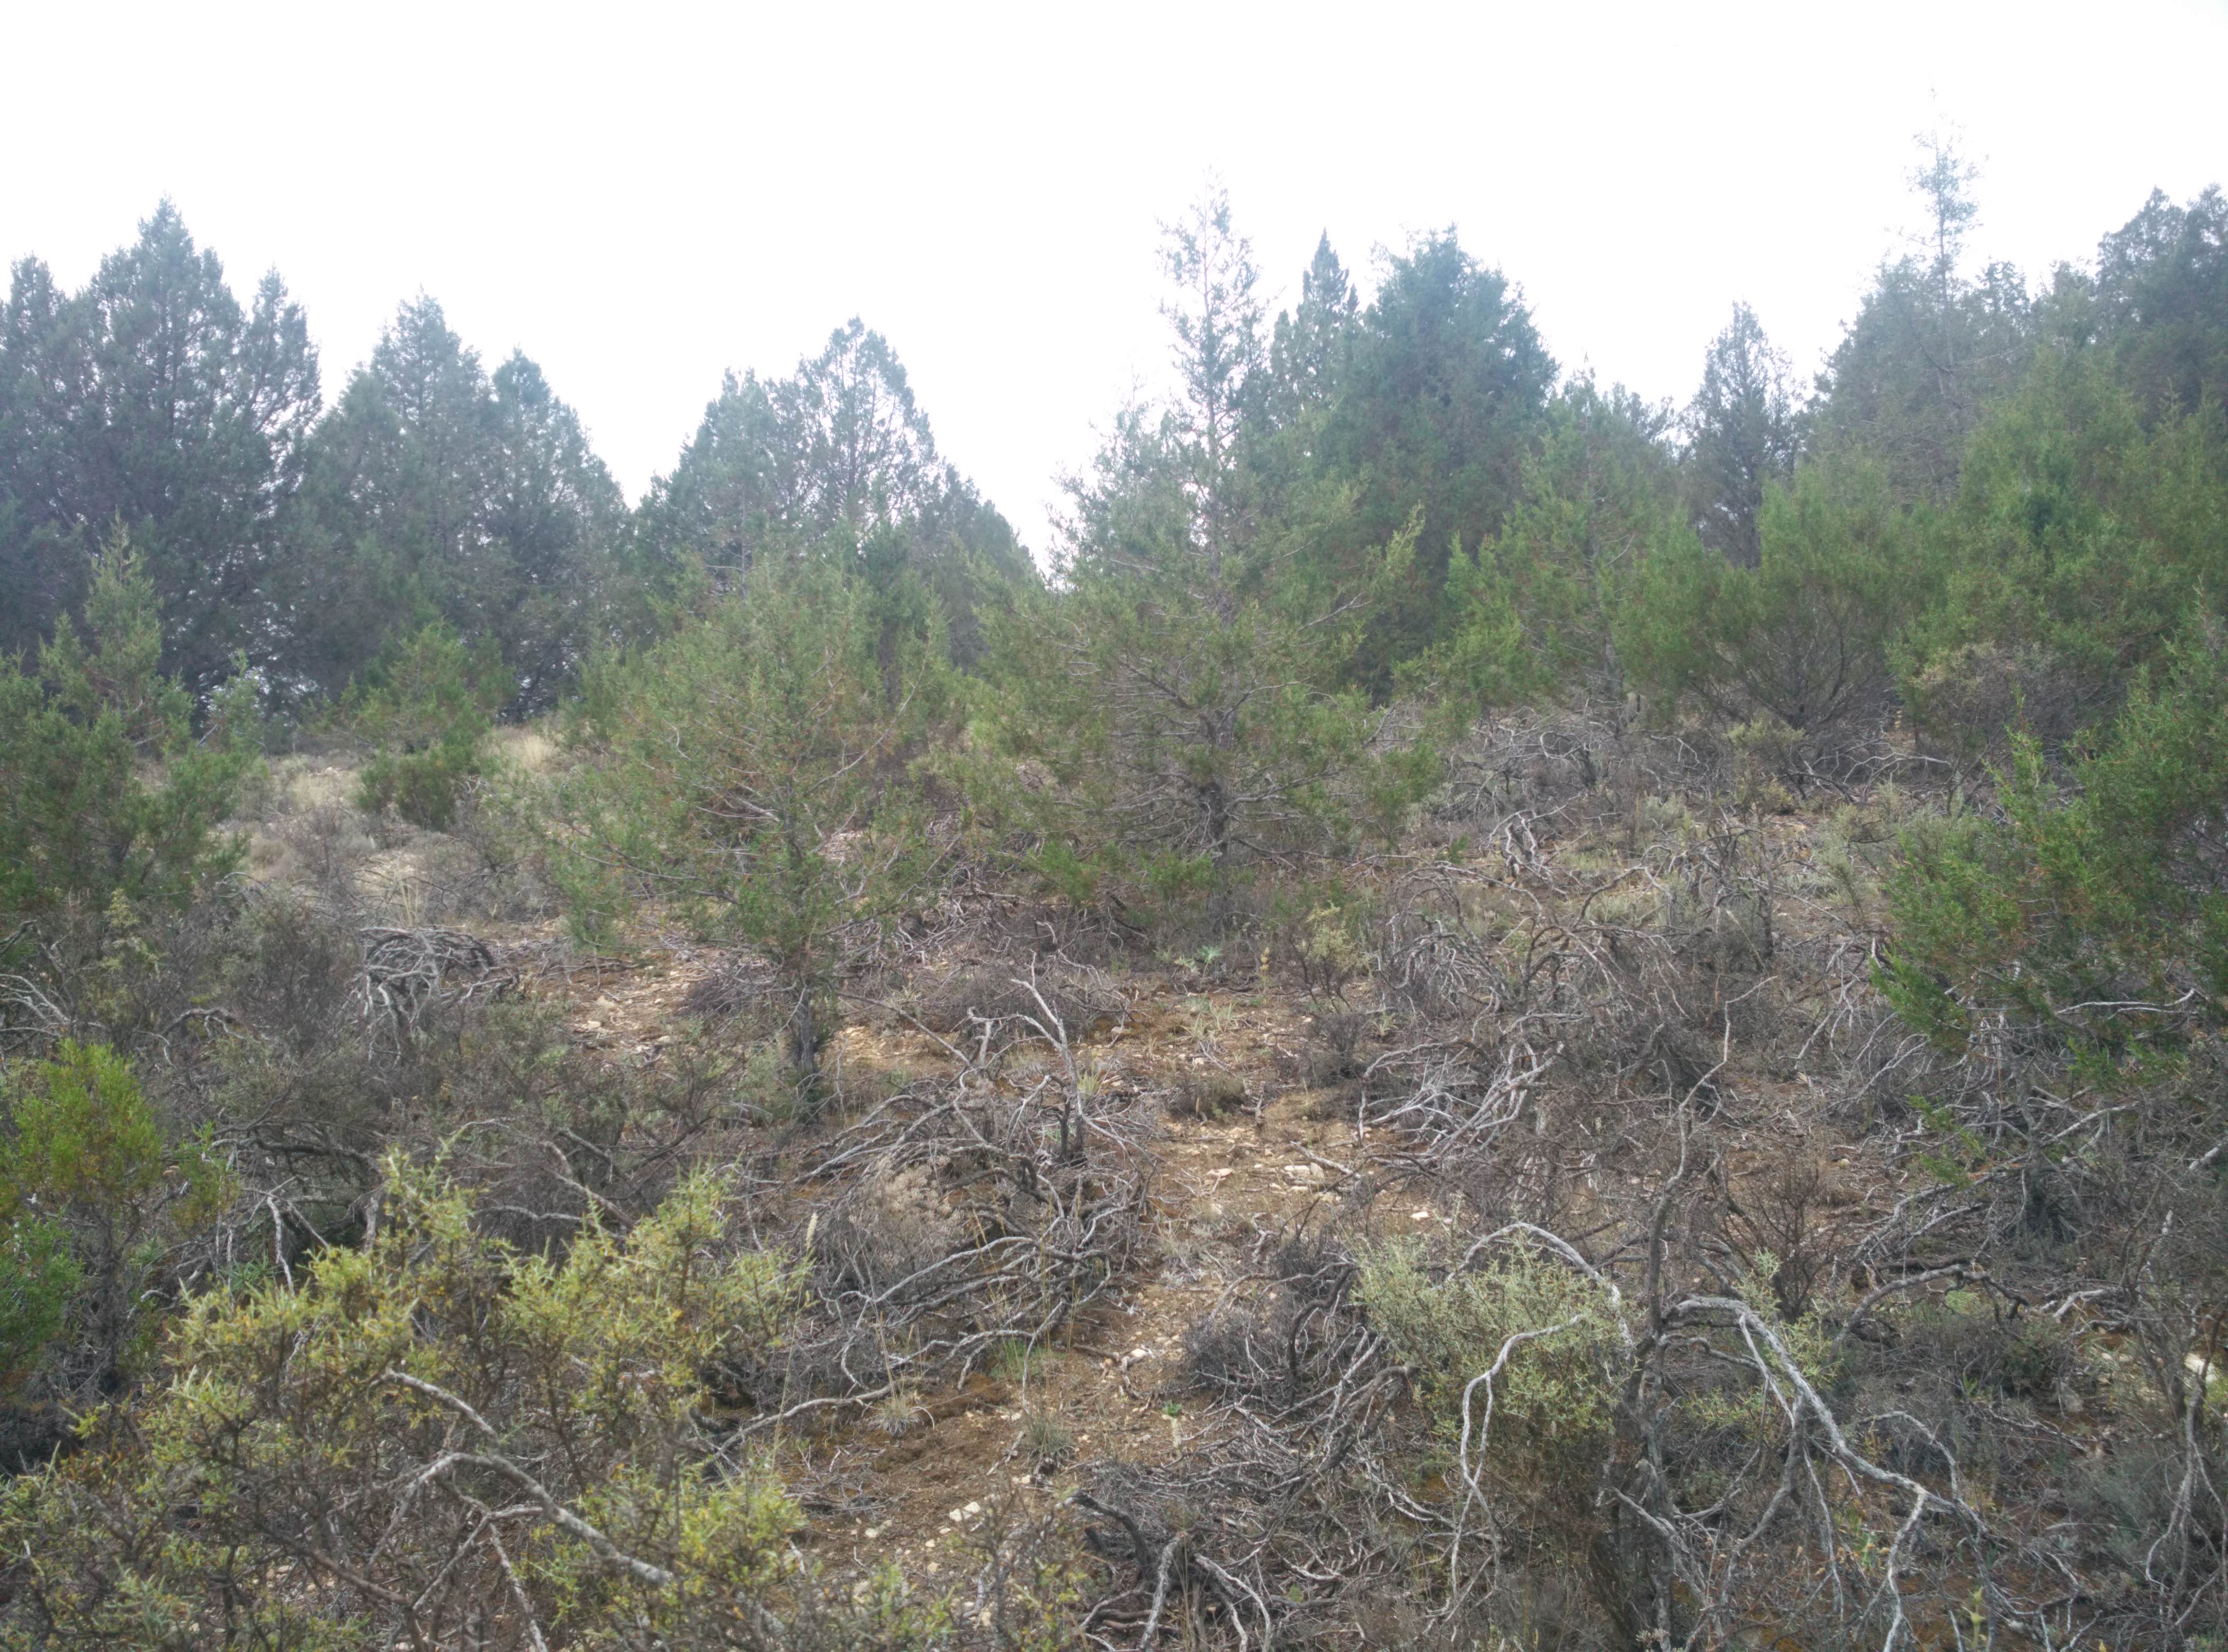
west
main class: Woodland
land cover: Other coniferous woodland
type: coniferous forest of the mediterranean region
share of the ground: 25 - 50 %
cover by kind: coniferous forest trees 40 %, herbaceous plants 30 %, unconsolidated bare surface 30 %
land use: Semi-natural and natural areas not in use
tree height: > 5 m
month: July
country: ES
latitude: 40.7999
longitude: -2.0538
